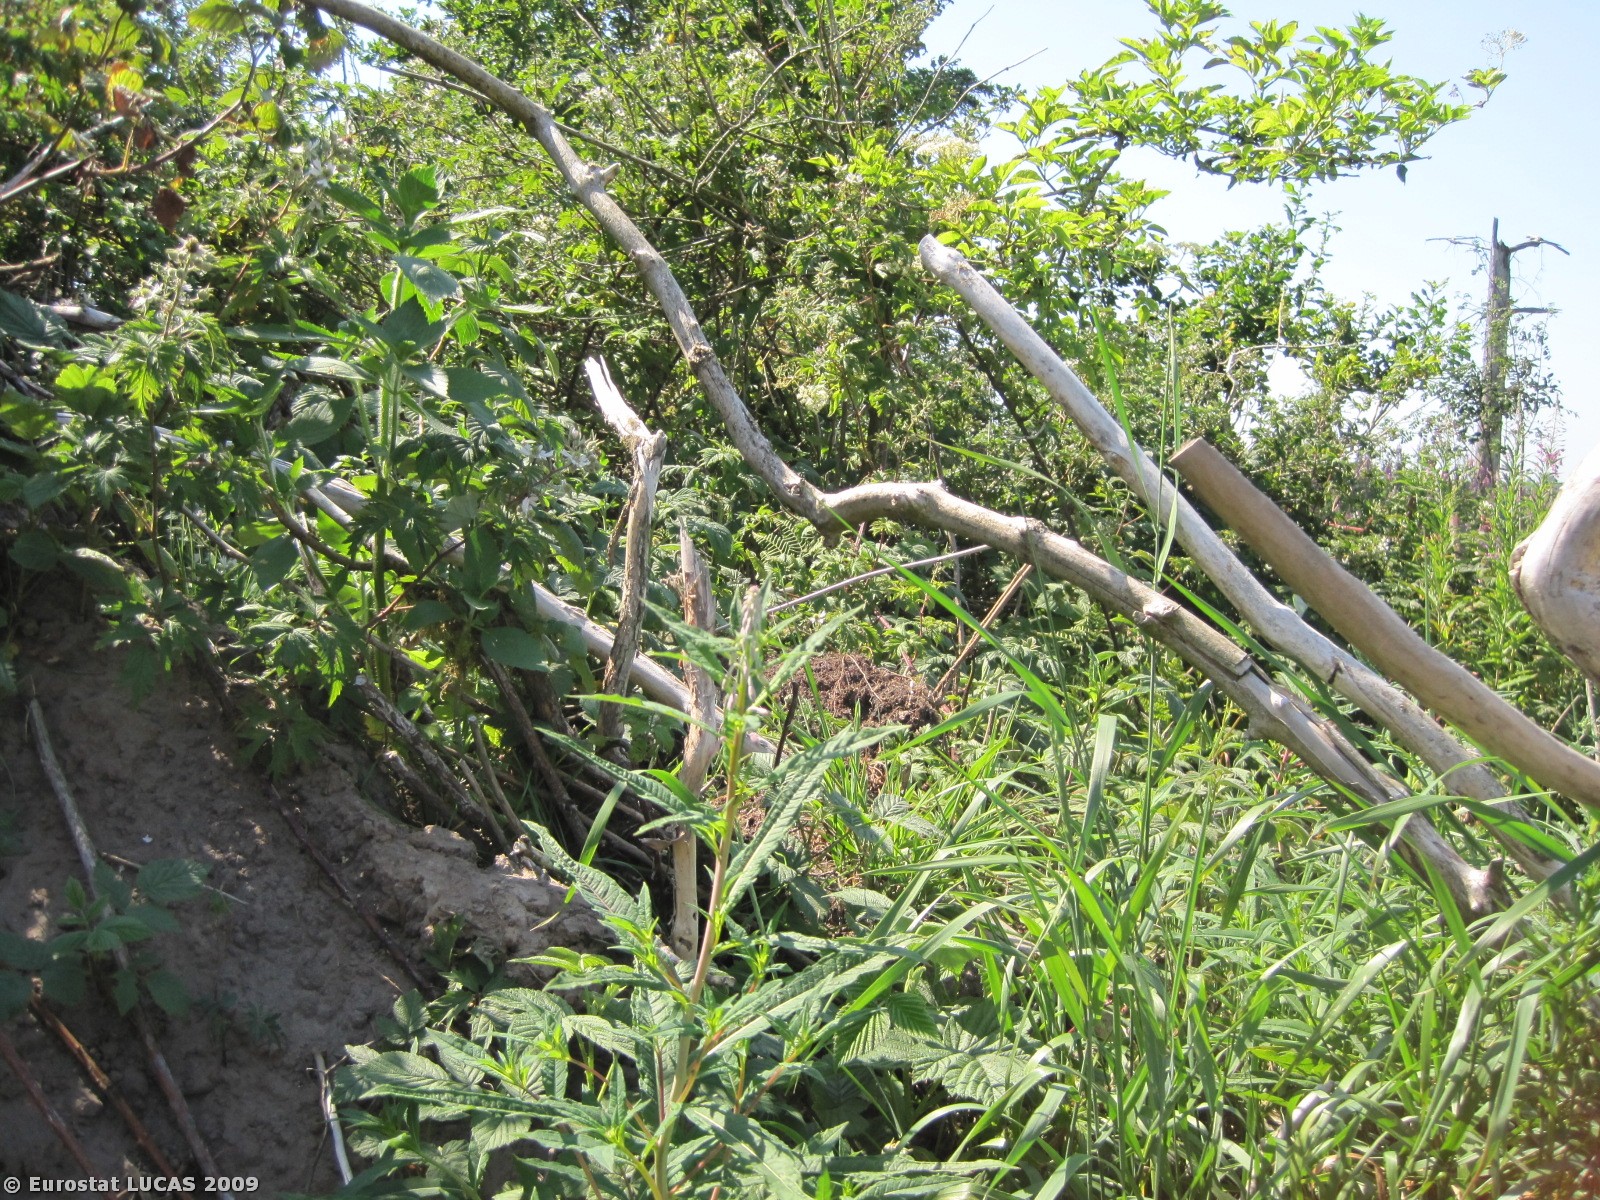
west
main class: Bare land
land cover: Bare land
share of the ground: > 75 %
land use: Unused
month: July
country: DK
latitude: 56.4107
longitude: 8.3326
